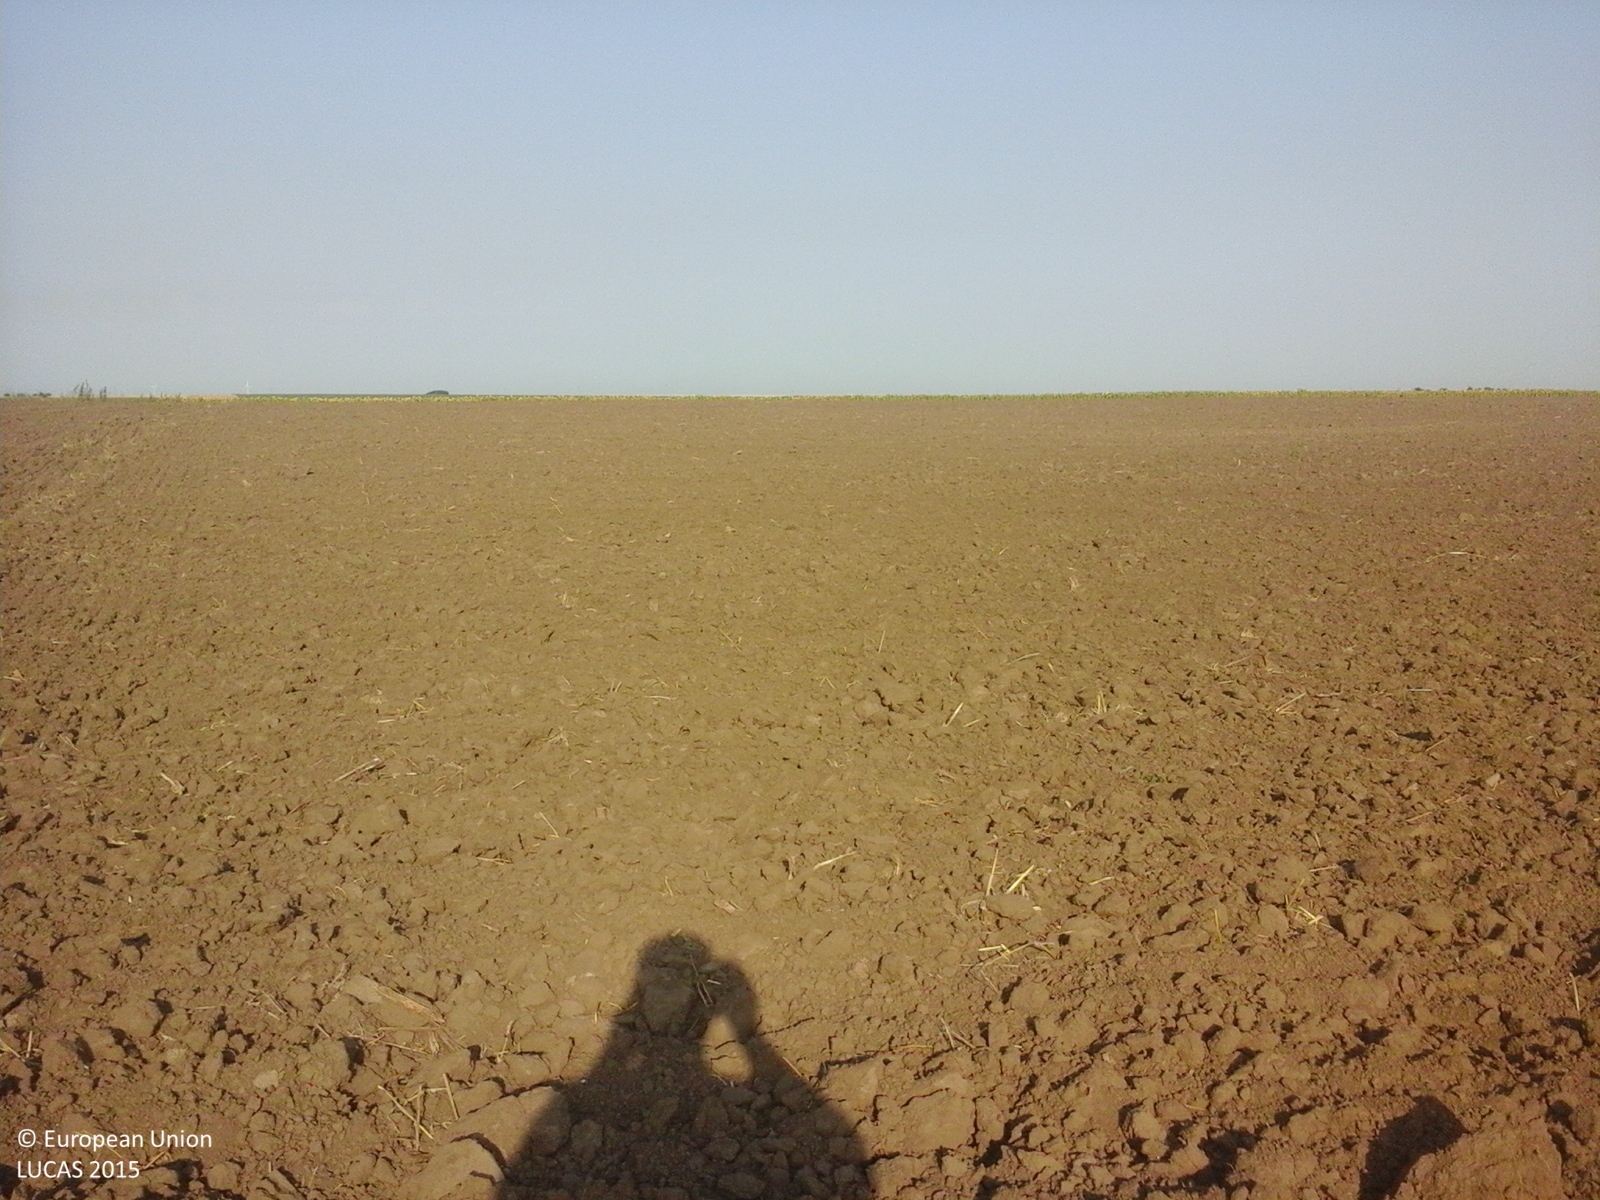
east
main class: Cropland
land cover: Sunflower
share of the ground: > 75 %
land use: Agriculture (excluding fallow land and kitchen gardens)
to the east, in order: Sunflower; Maize; Tracks; Grass margins; Other bare soil
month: August
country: RO
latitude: 44.0755
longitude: 28.0735
